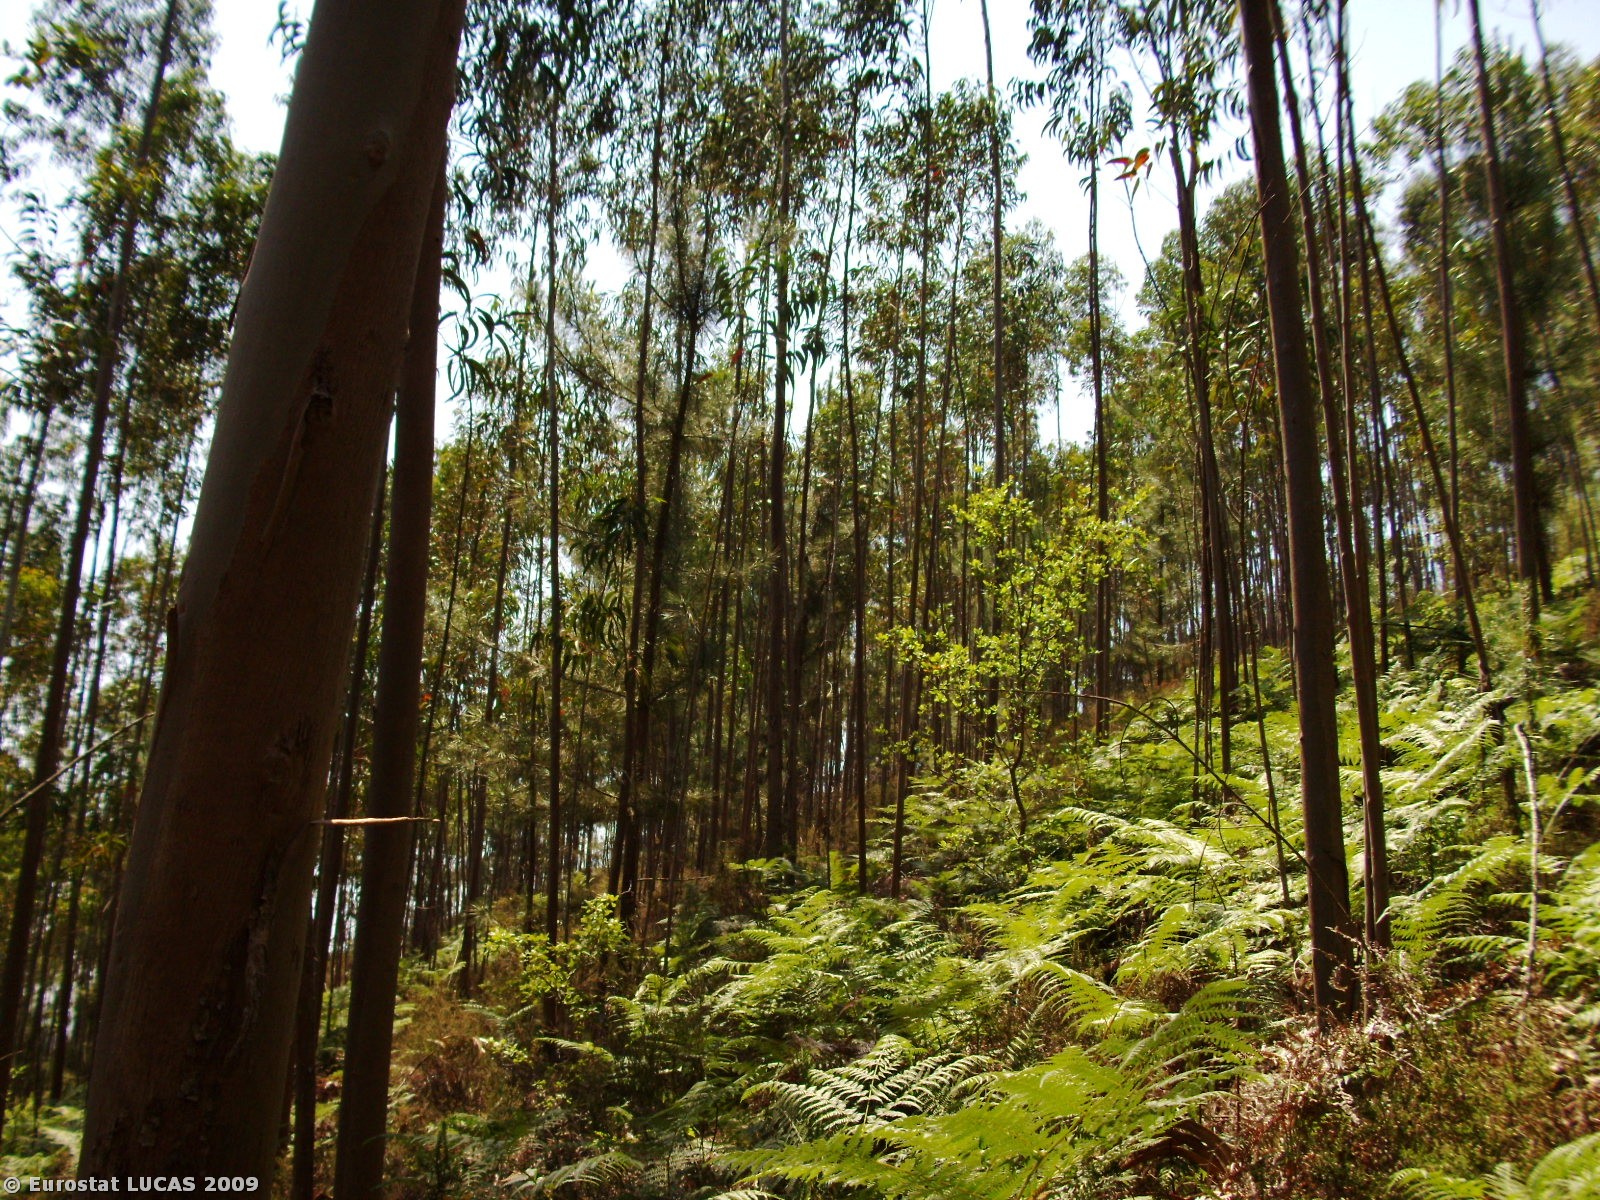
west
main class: Woodland
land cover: Broadleaved woodland
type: plantations and self-sown exotic forest
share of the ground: > 75 %
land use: Forestry
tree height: > 5 m
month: May
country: PT
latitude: 40.2684
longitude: -8.3931
